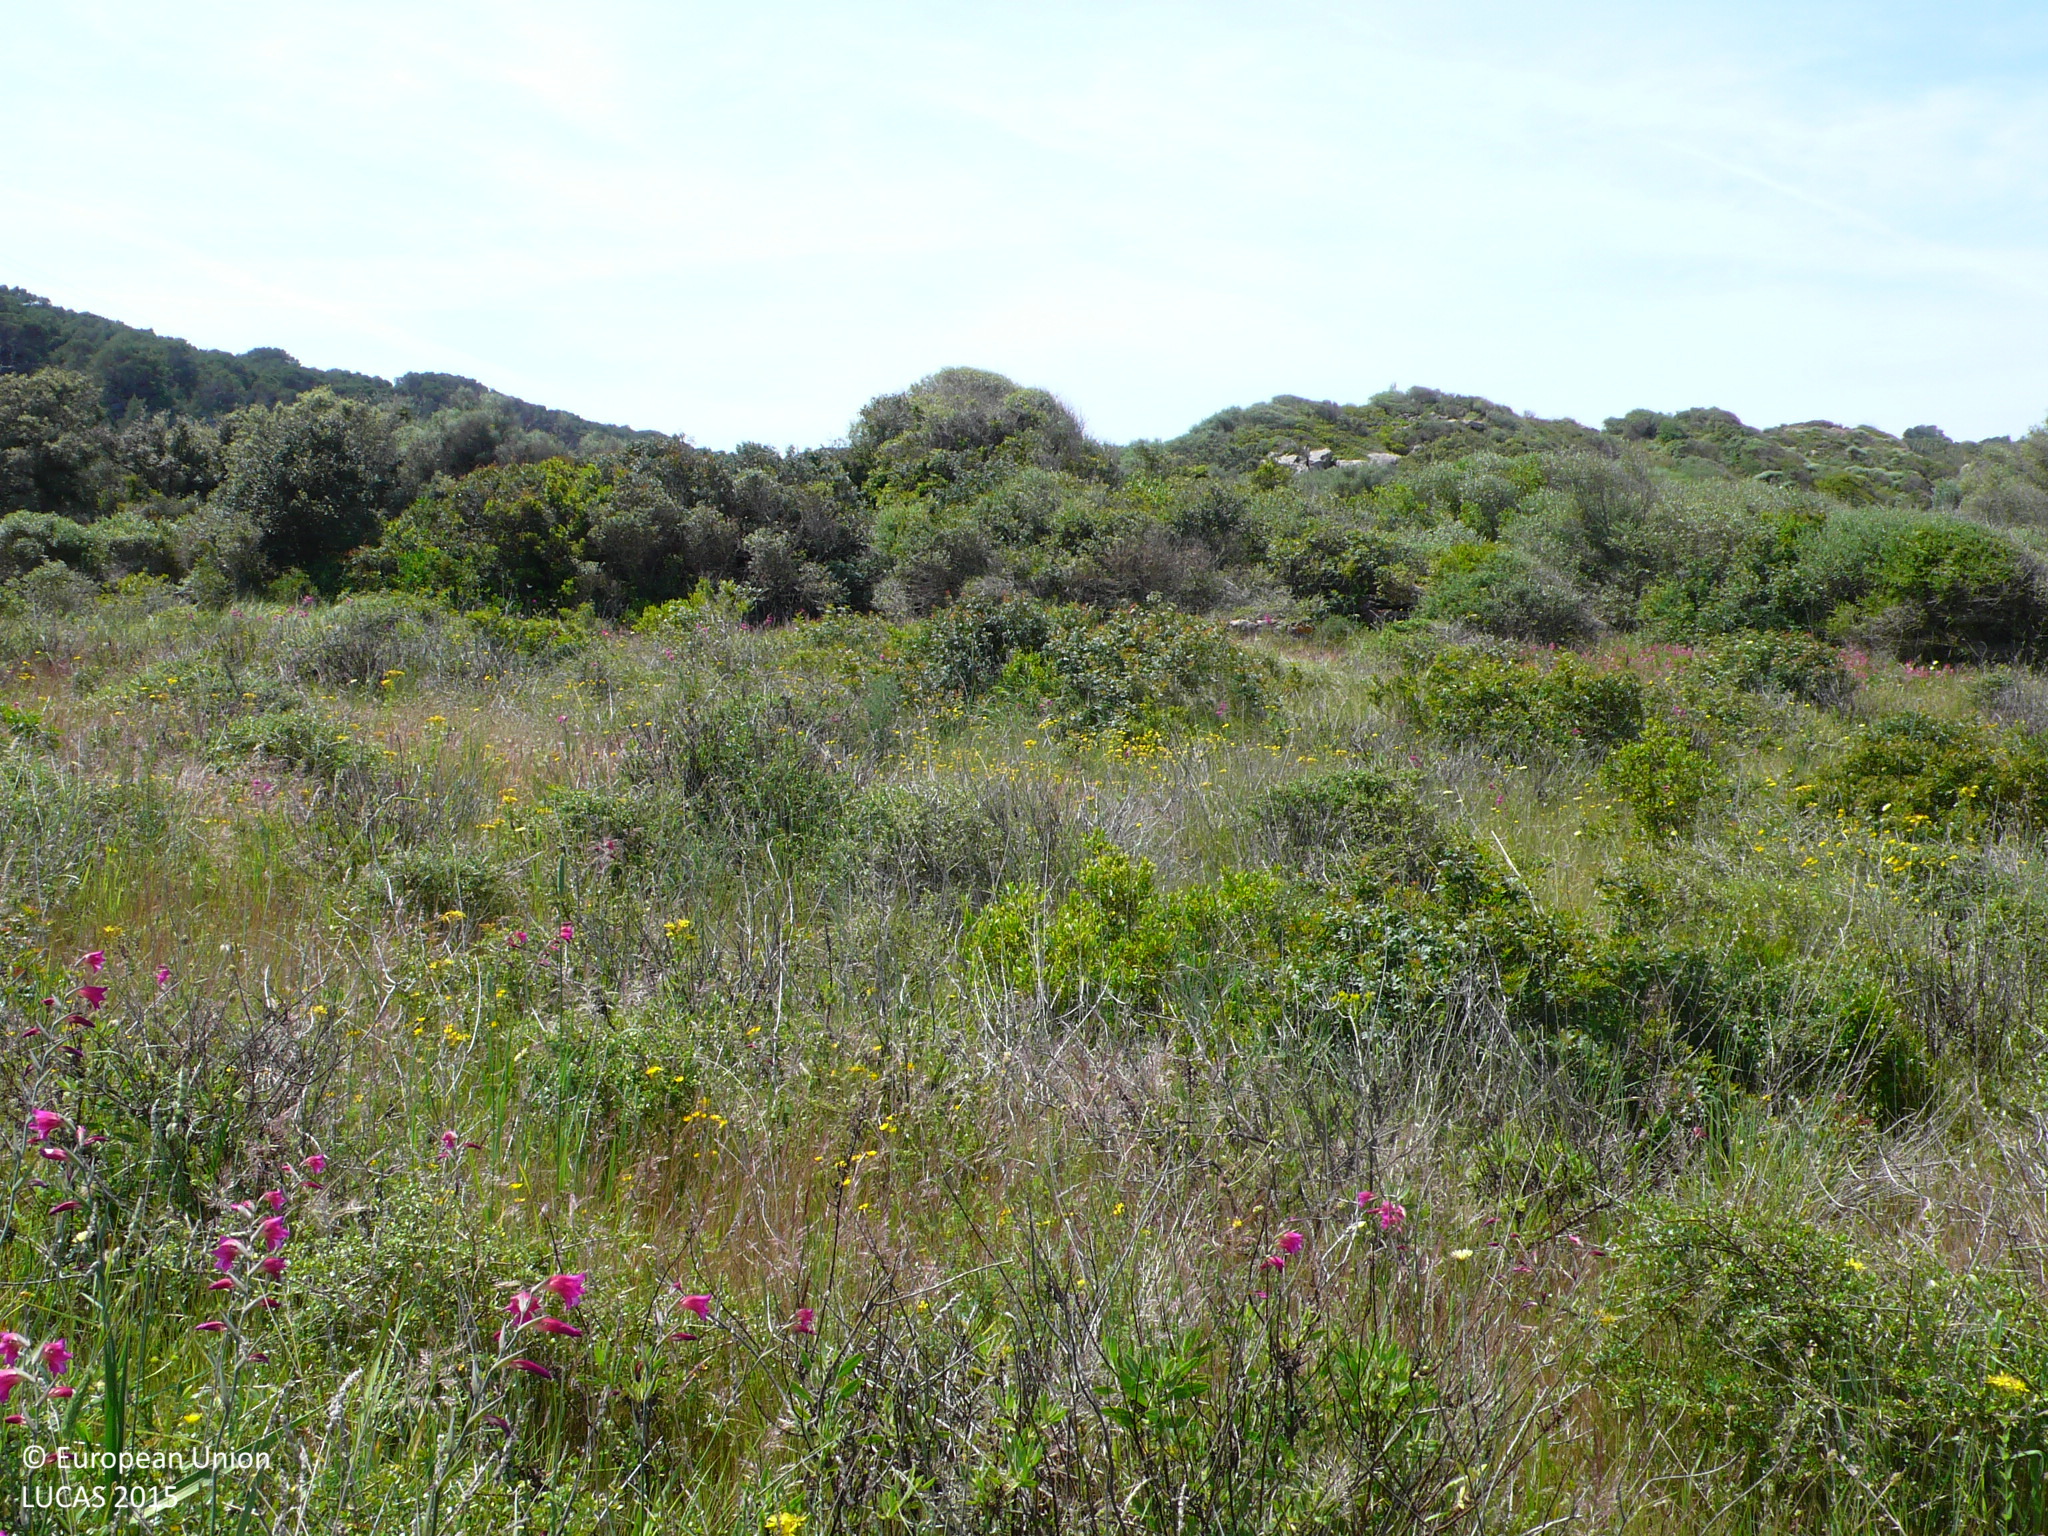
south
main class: Shrubland
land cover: Shrubland with sparse tree cover
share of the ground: 50 - 75 %
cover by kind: shrubs 55 %, herbaceous plants 40 %, broadleaved forest trees 5 %
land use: Semi-natural and natural areas not in use
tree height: < 5 m
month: May
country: ES
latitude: 40.0038
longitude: 4.1804
